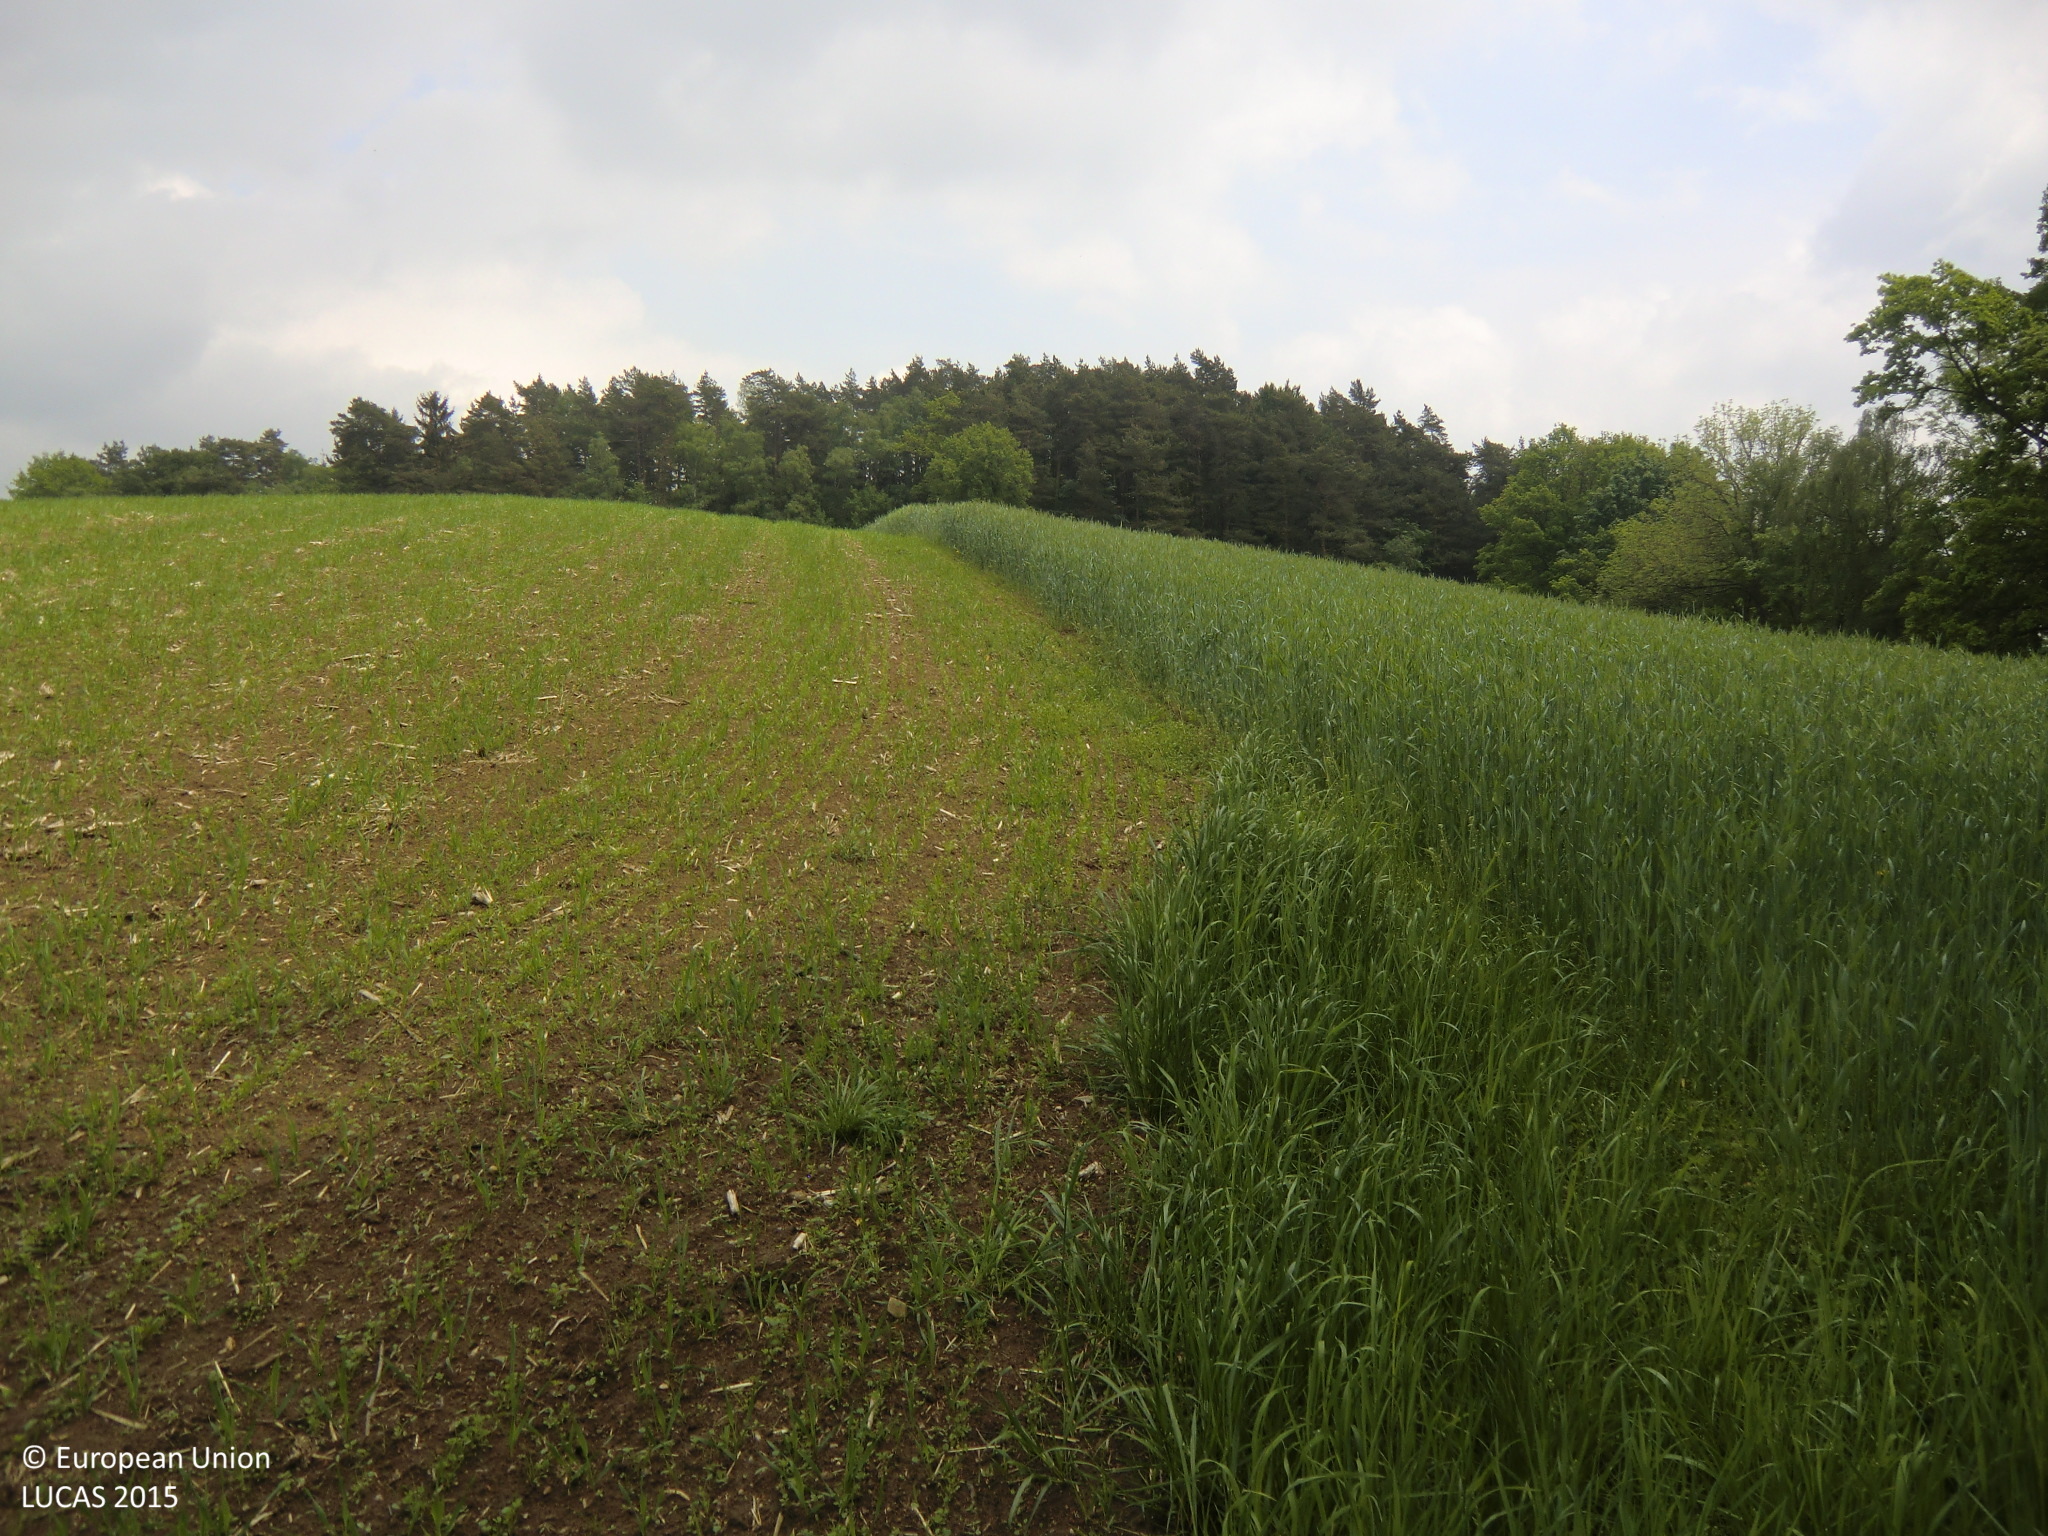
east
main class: Cropland
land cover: Clovers
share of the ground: 25 - 50 %
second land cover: Rye
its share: 25 - 50 %
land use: Agriculture (excluding fallow land and kitchen gardens)
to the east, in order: Clovers; Grassland without tree/shrub cover; Common wheat; Pine dominated mixed woodland; Spruce dominated mixed woodland; Shrubland without tree cover; Spruce dominated mixed woodland; Shrubland without tree cover
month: May
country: AT
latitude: 48.3895
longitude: 14.3623
